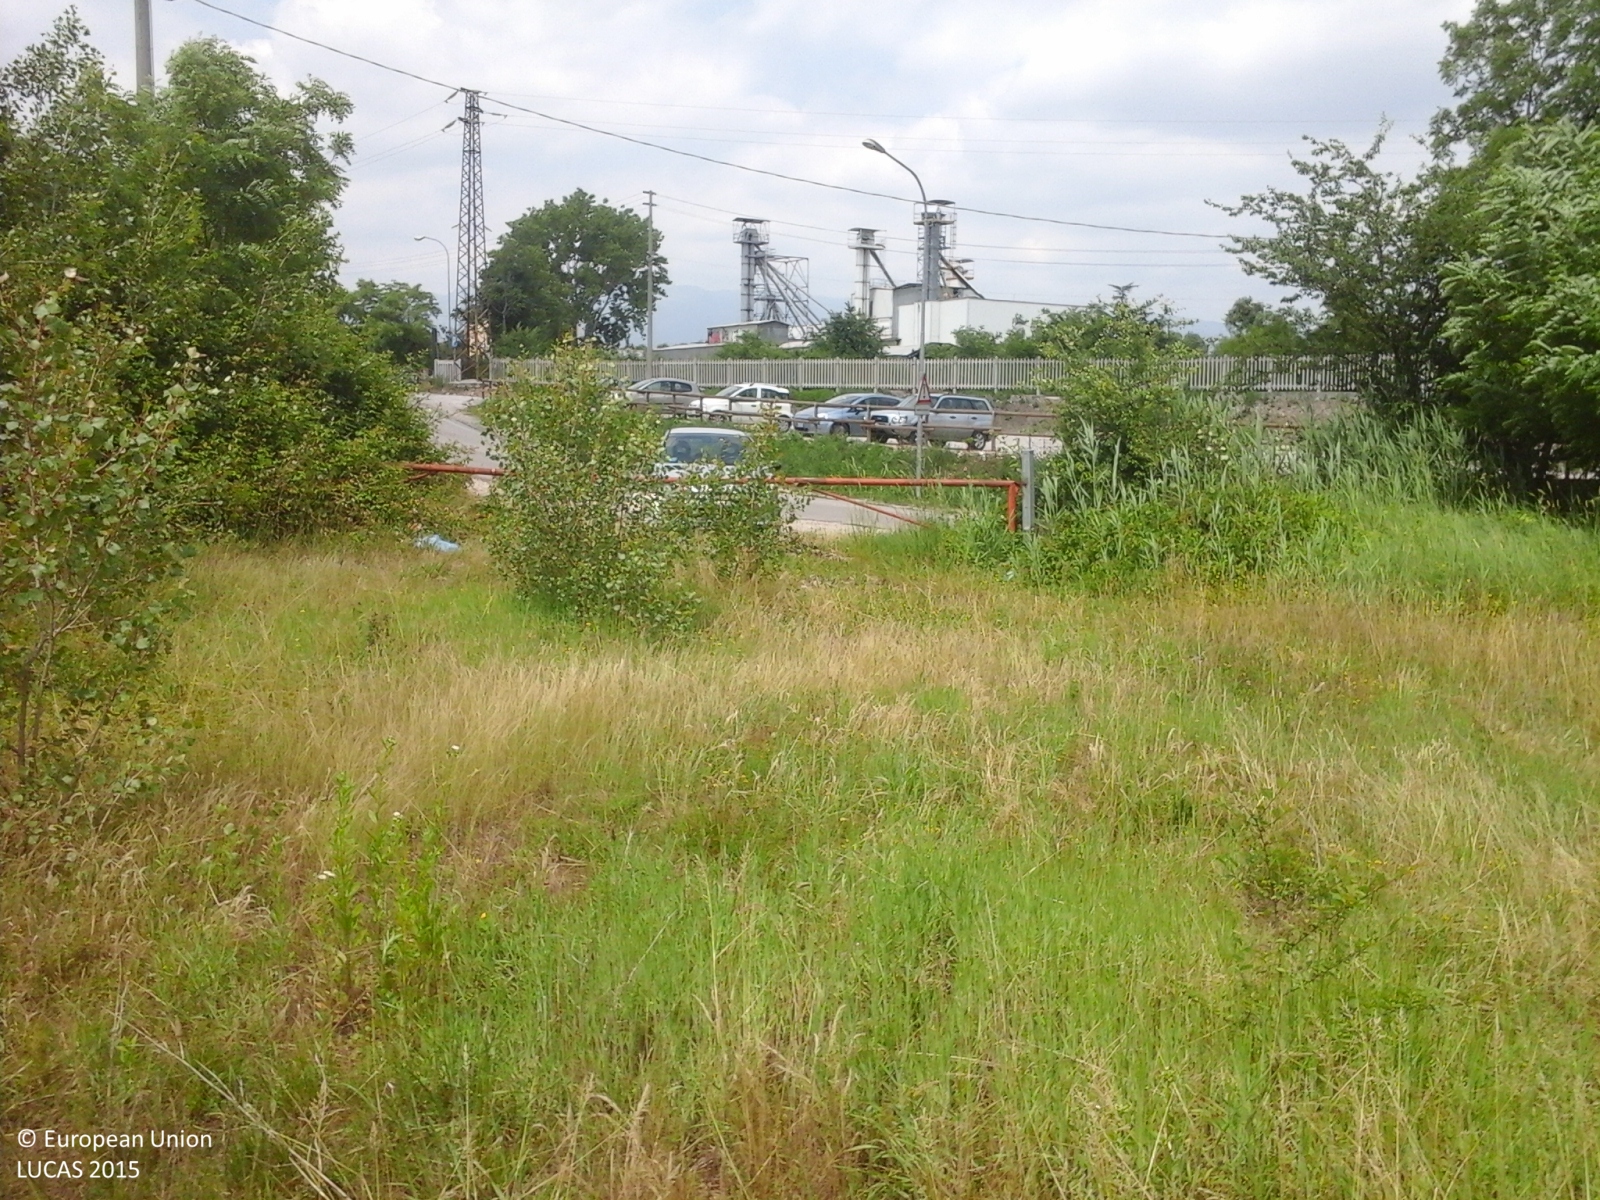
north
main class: Grassland
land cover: Grassland with sparse tree/shrub cover
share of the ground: > 75 %
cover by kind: herbaceous plants 95 %, broadleaved forest trees 5 %
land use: Abandoned areas
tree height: < 5 m
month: May
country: IT
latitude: 45.6556
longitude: 11.5247
